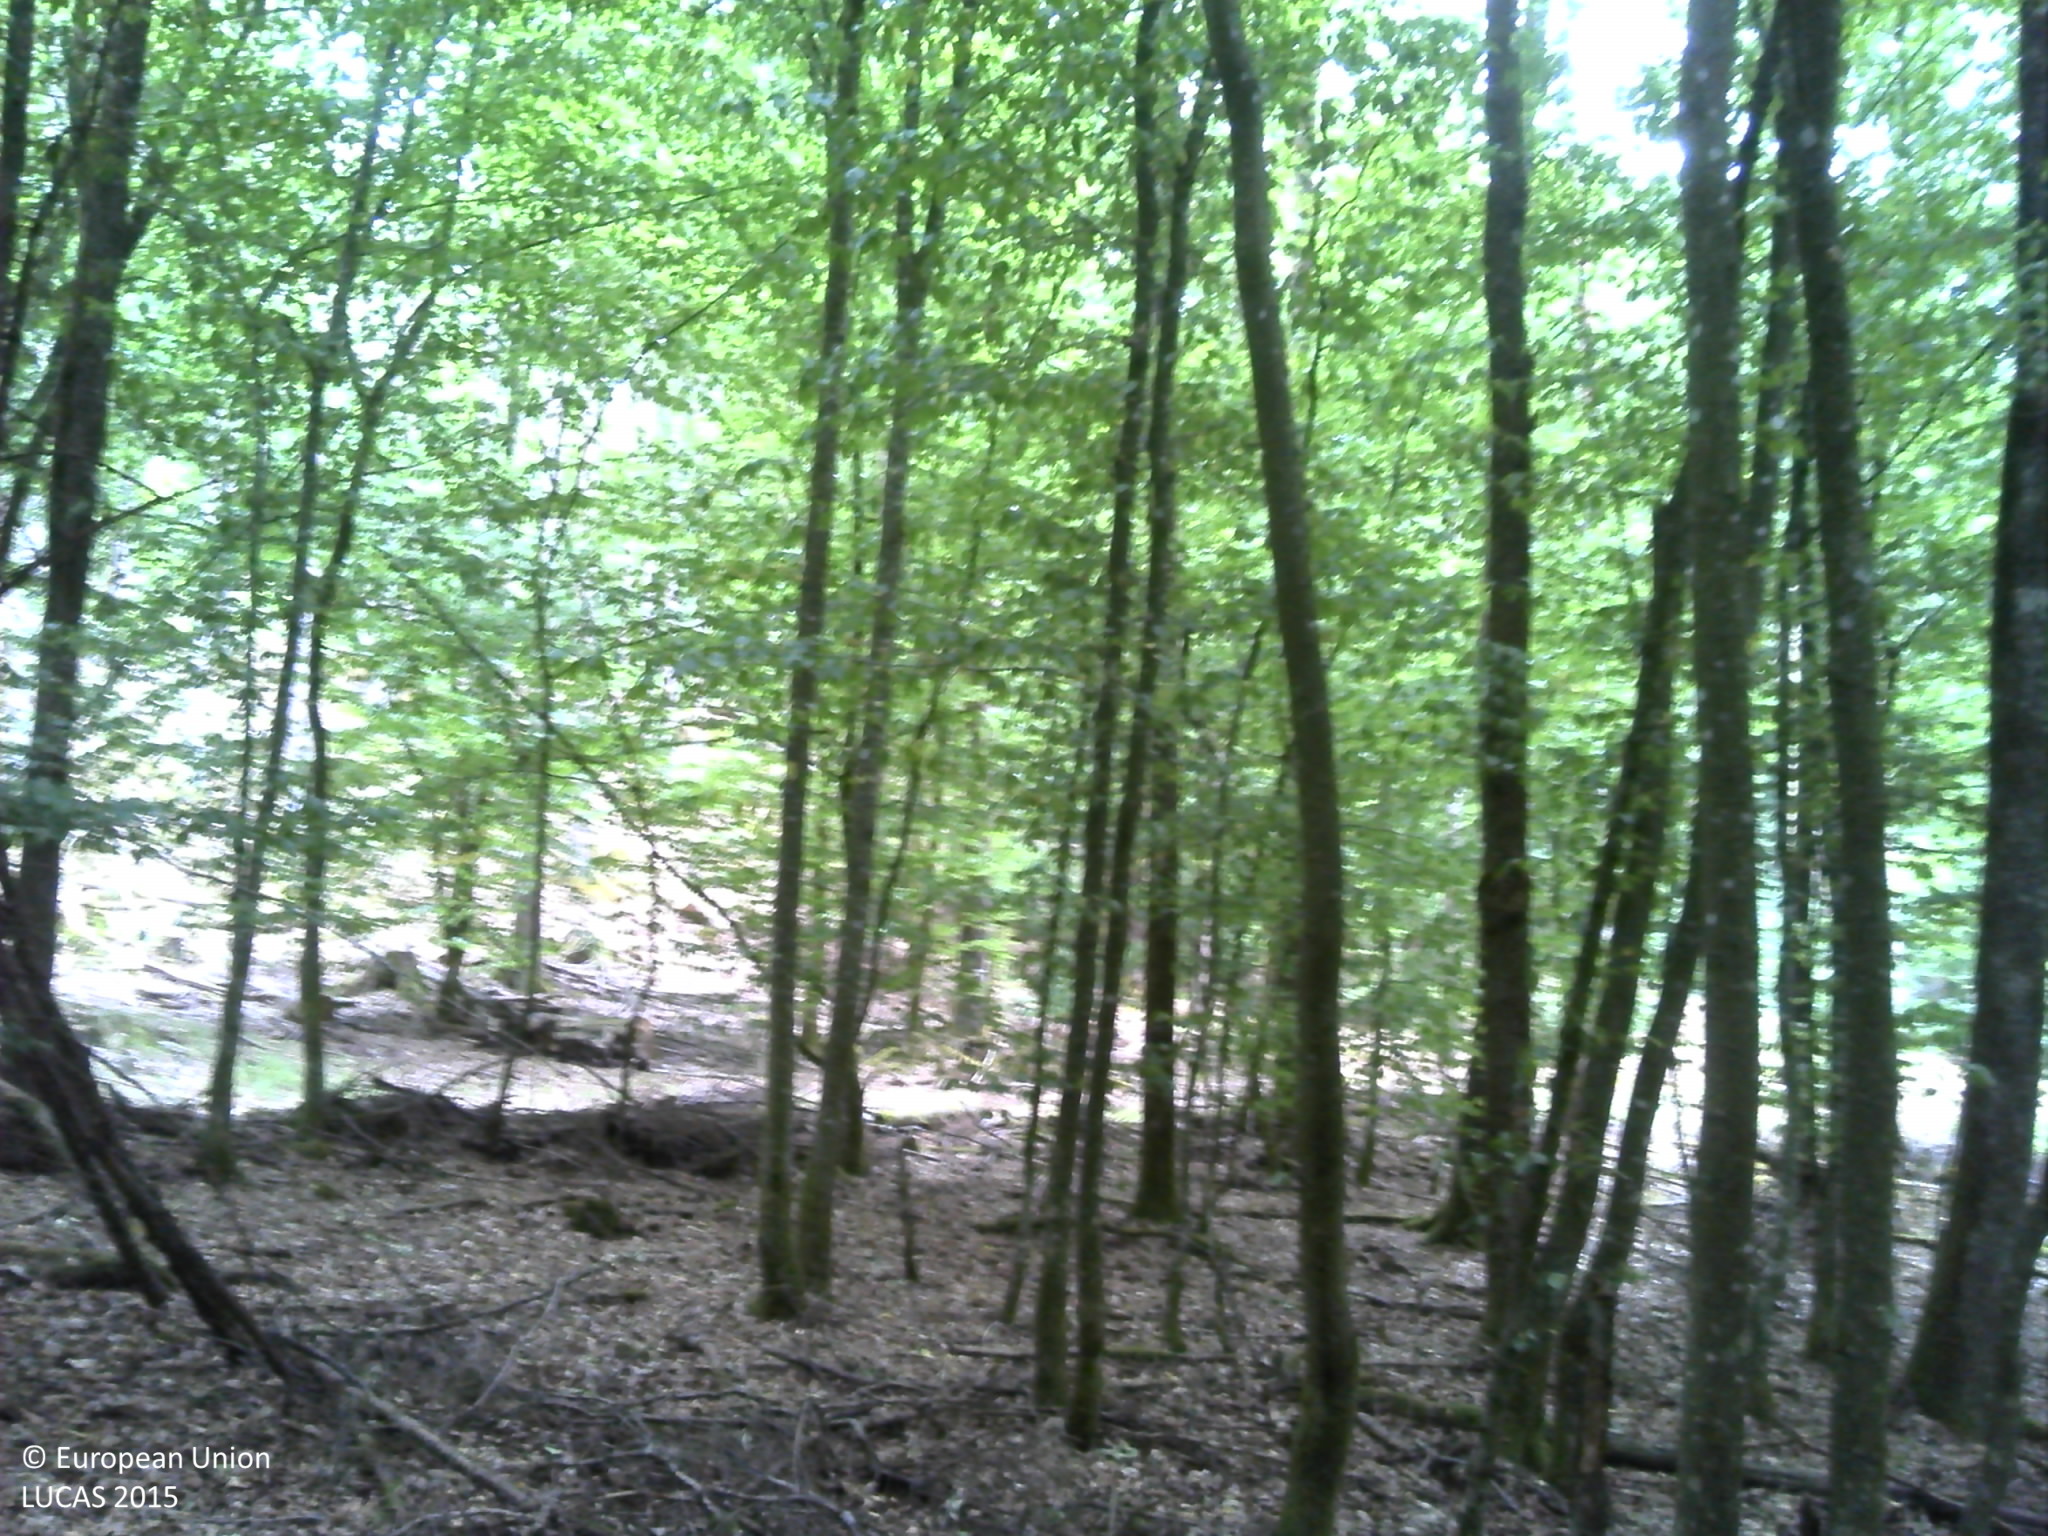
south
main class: Woodland
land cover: Broadleaved woodland
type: mesophytic deciduous forest
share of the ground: > 75 %
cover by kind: broadleaved forest trees 100 %
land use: Forestry
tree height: > 5 m
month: July
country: FR
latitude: 49.0418
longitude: 7.5244
